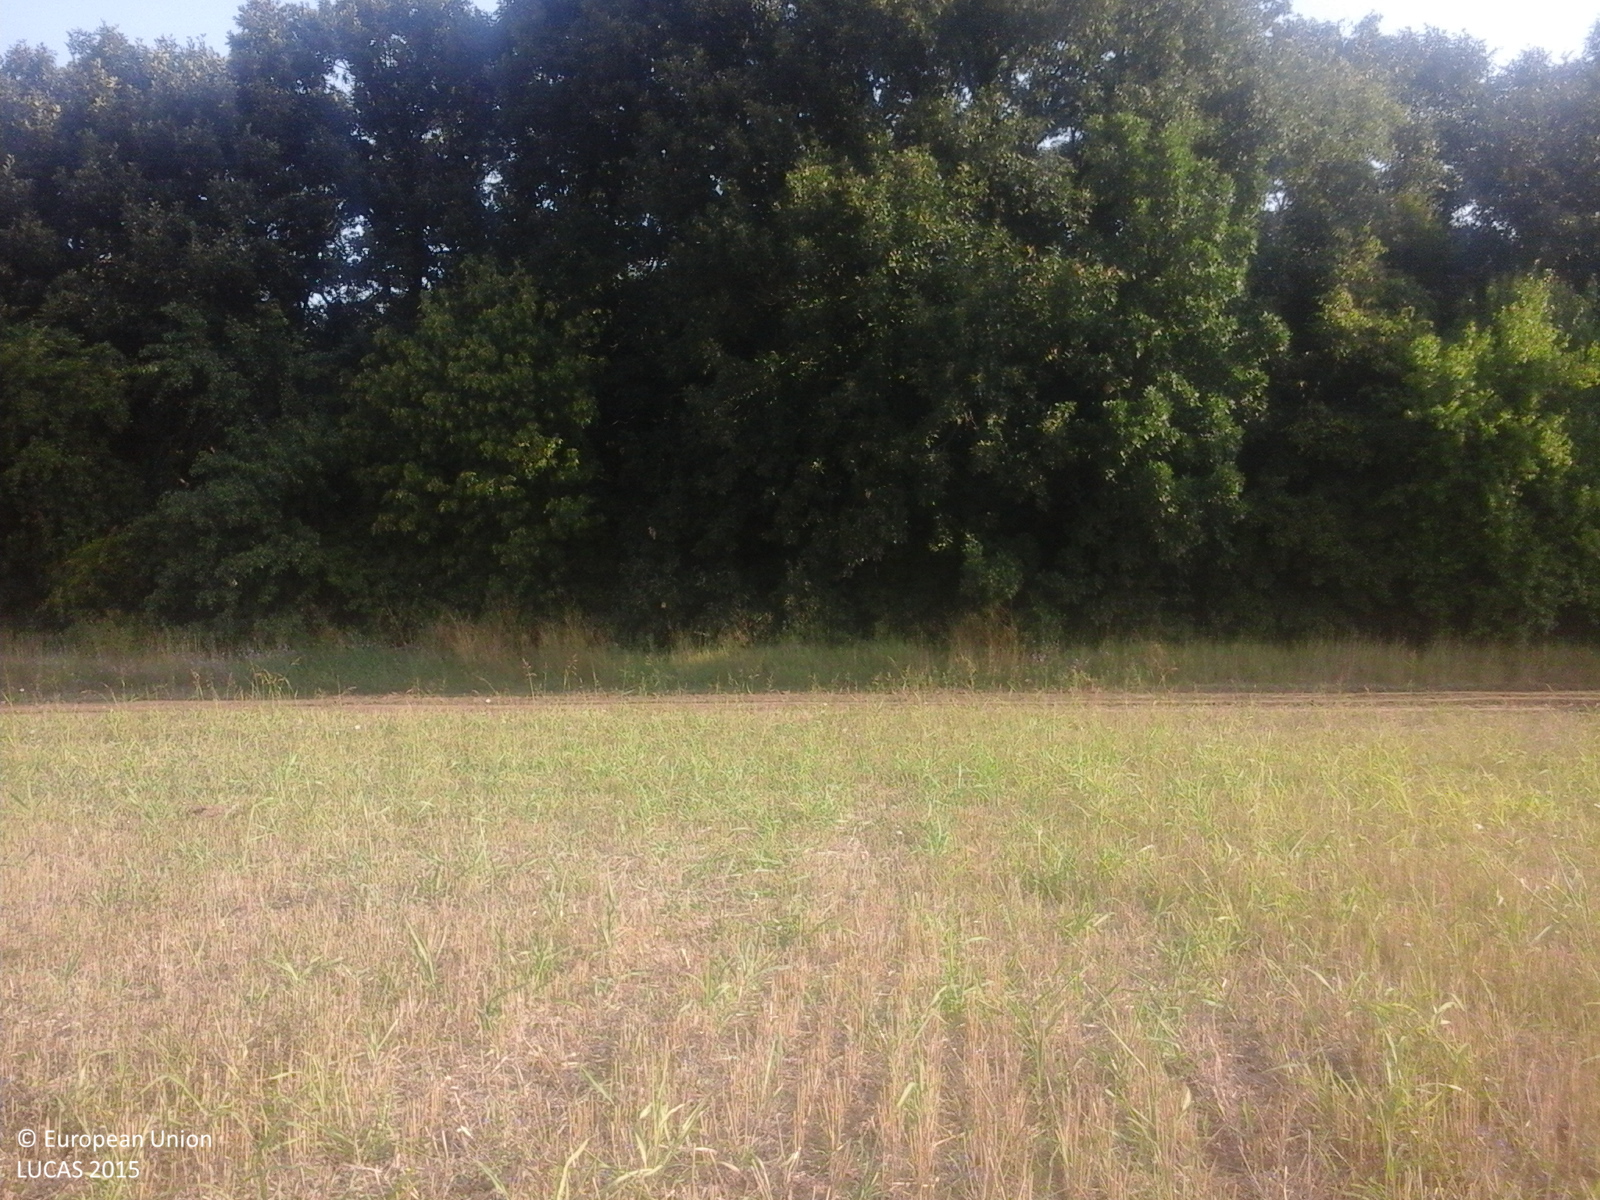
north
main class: Cropland
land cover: Barley
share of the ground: 50 - 75 %
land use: Agriculture (excluding fallow land and kitchen gardens)
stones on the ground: < 10 %
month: August
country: RO
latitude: 44.0265
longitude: 27.7232
